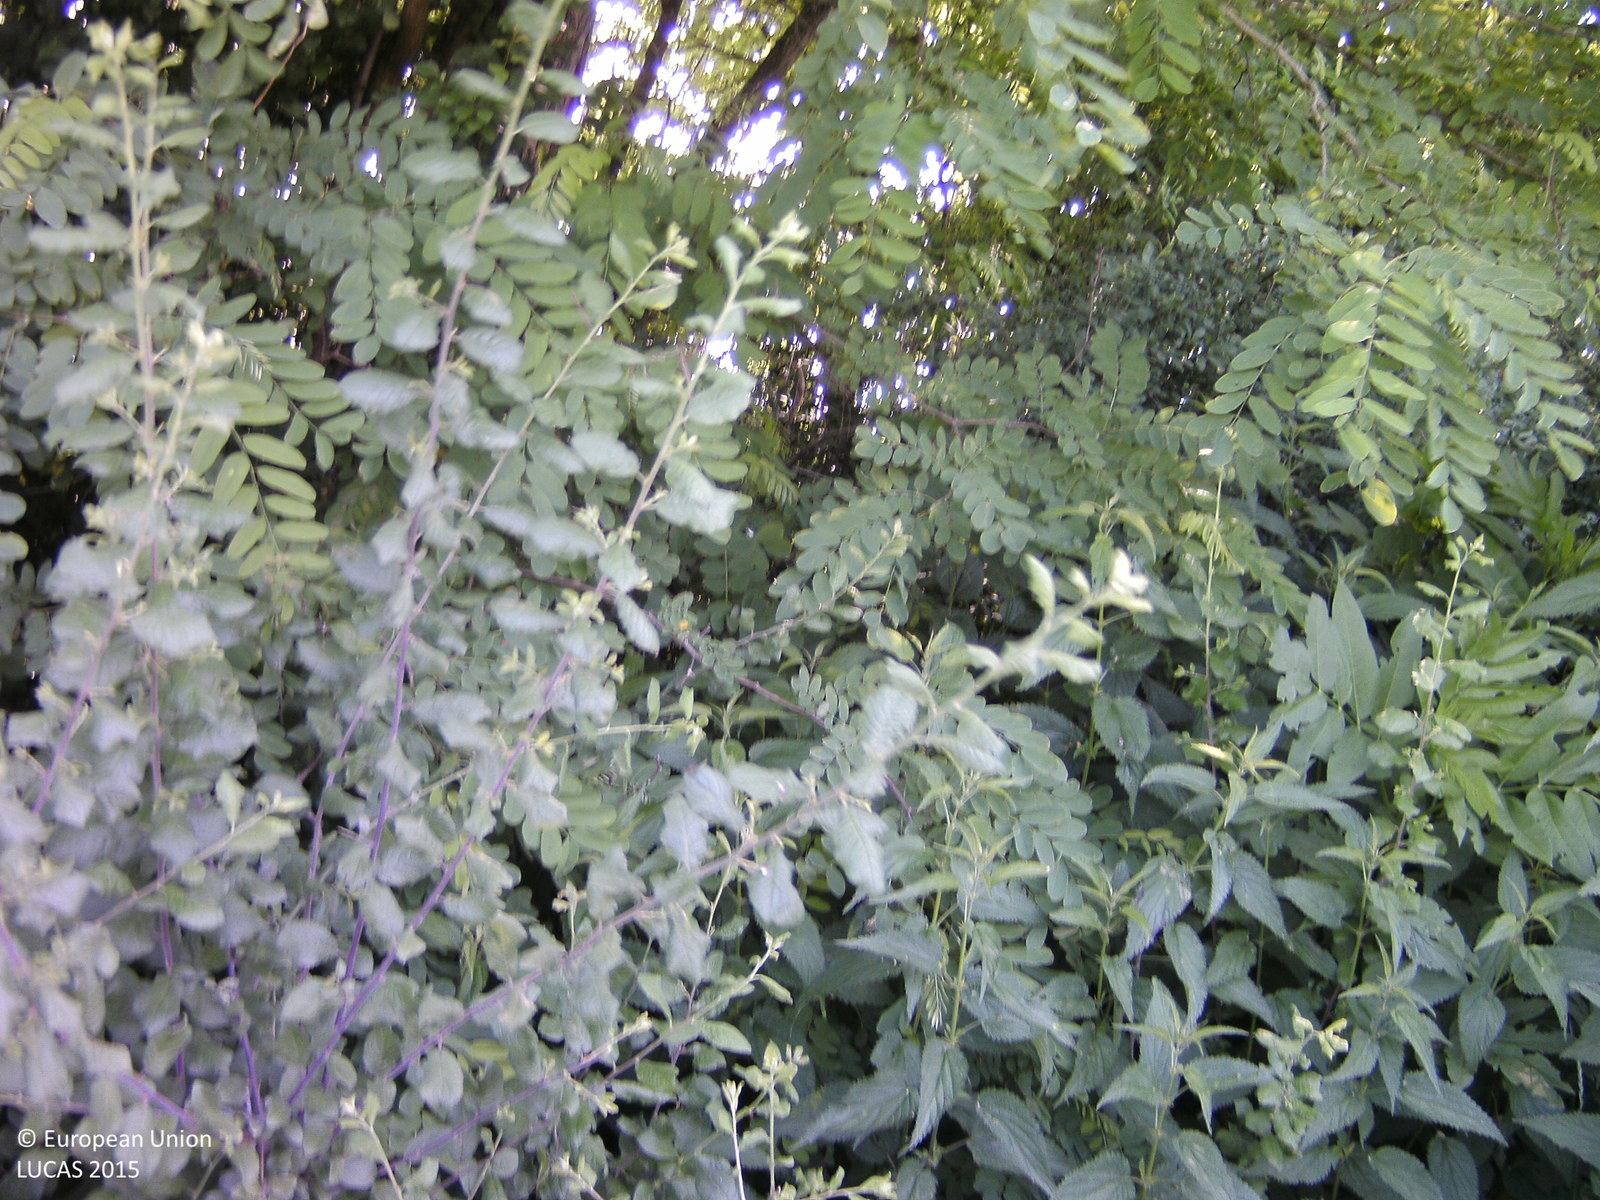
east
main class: Cropland
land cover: Rape and turnip rape
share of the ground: > 75 %
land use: Agriculture (excluding fallow land and kitchen gardens)
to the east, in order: Rape and turnip rape; Broadleaved woodland; Barley; Sunflower
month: June
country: HU
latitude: 46.4464
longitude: 18.0392
